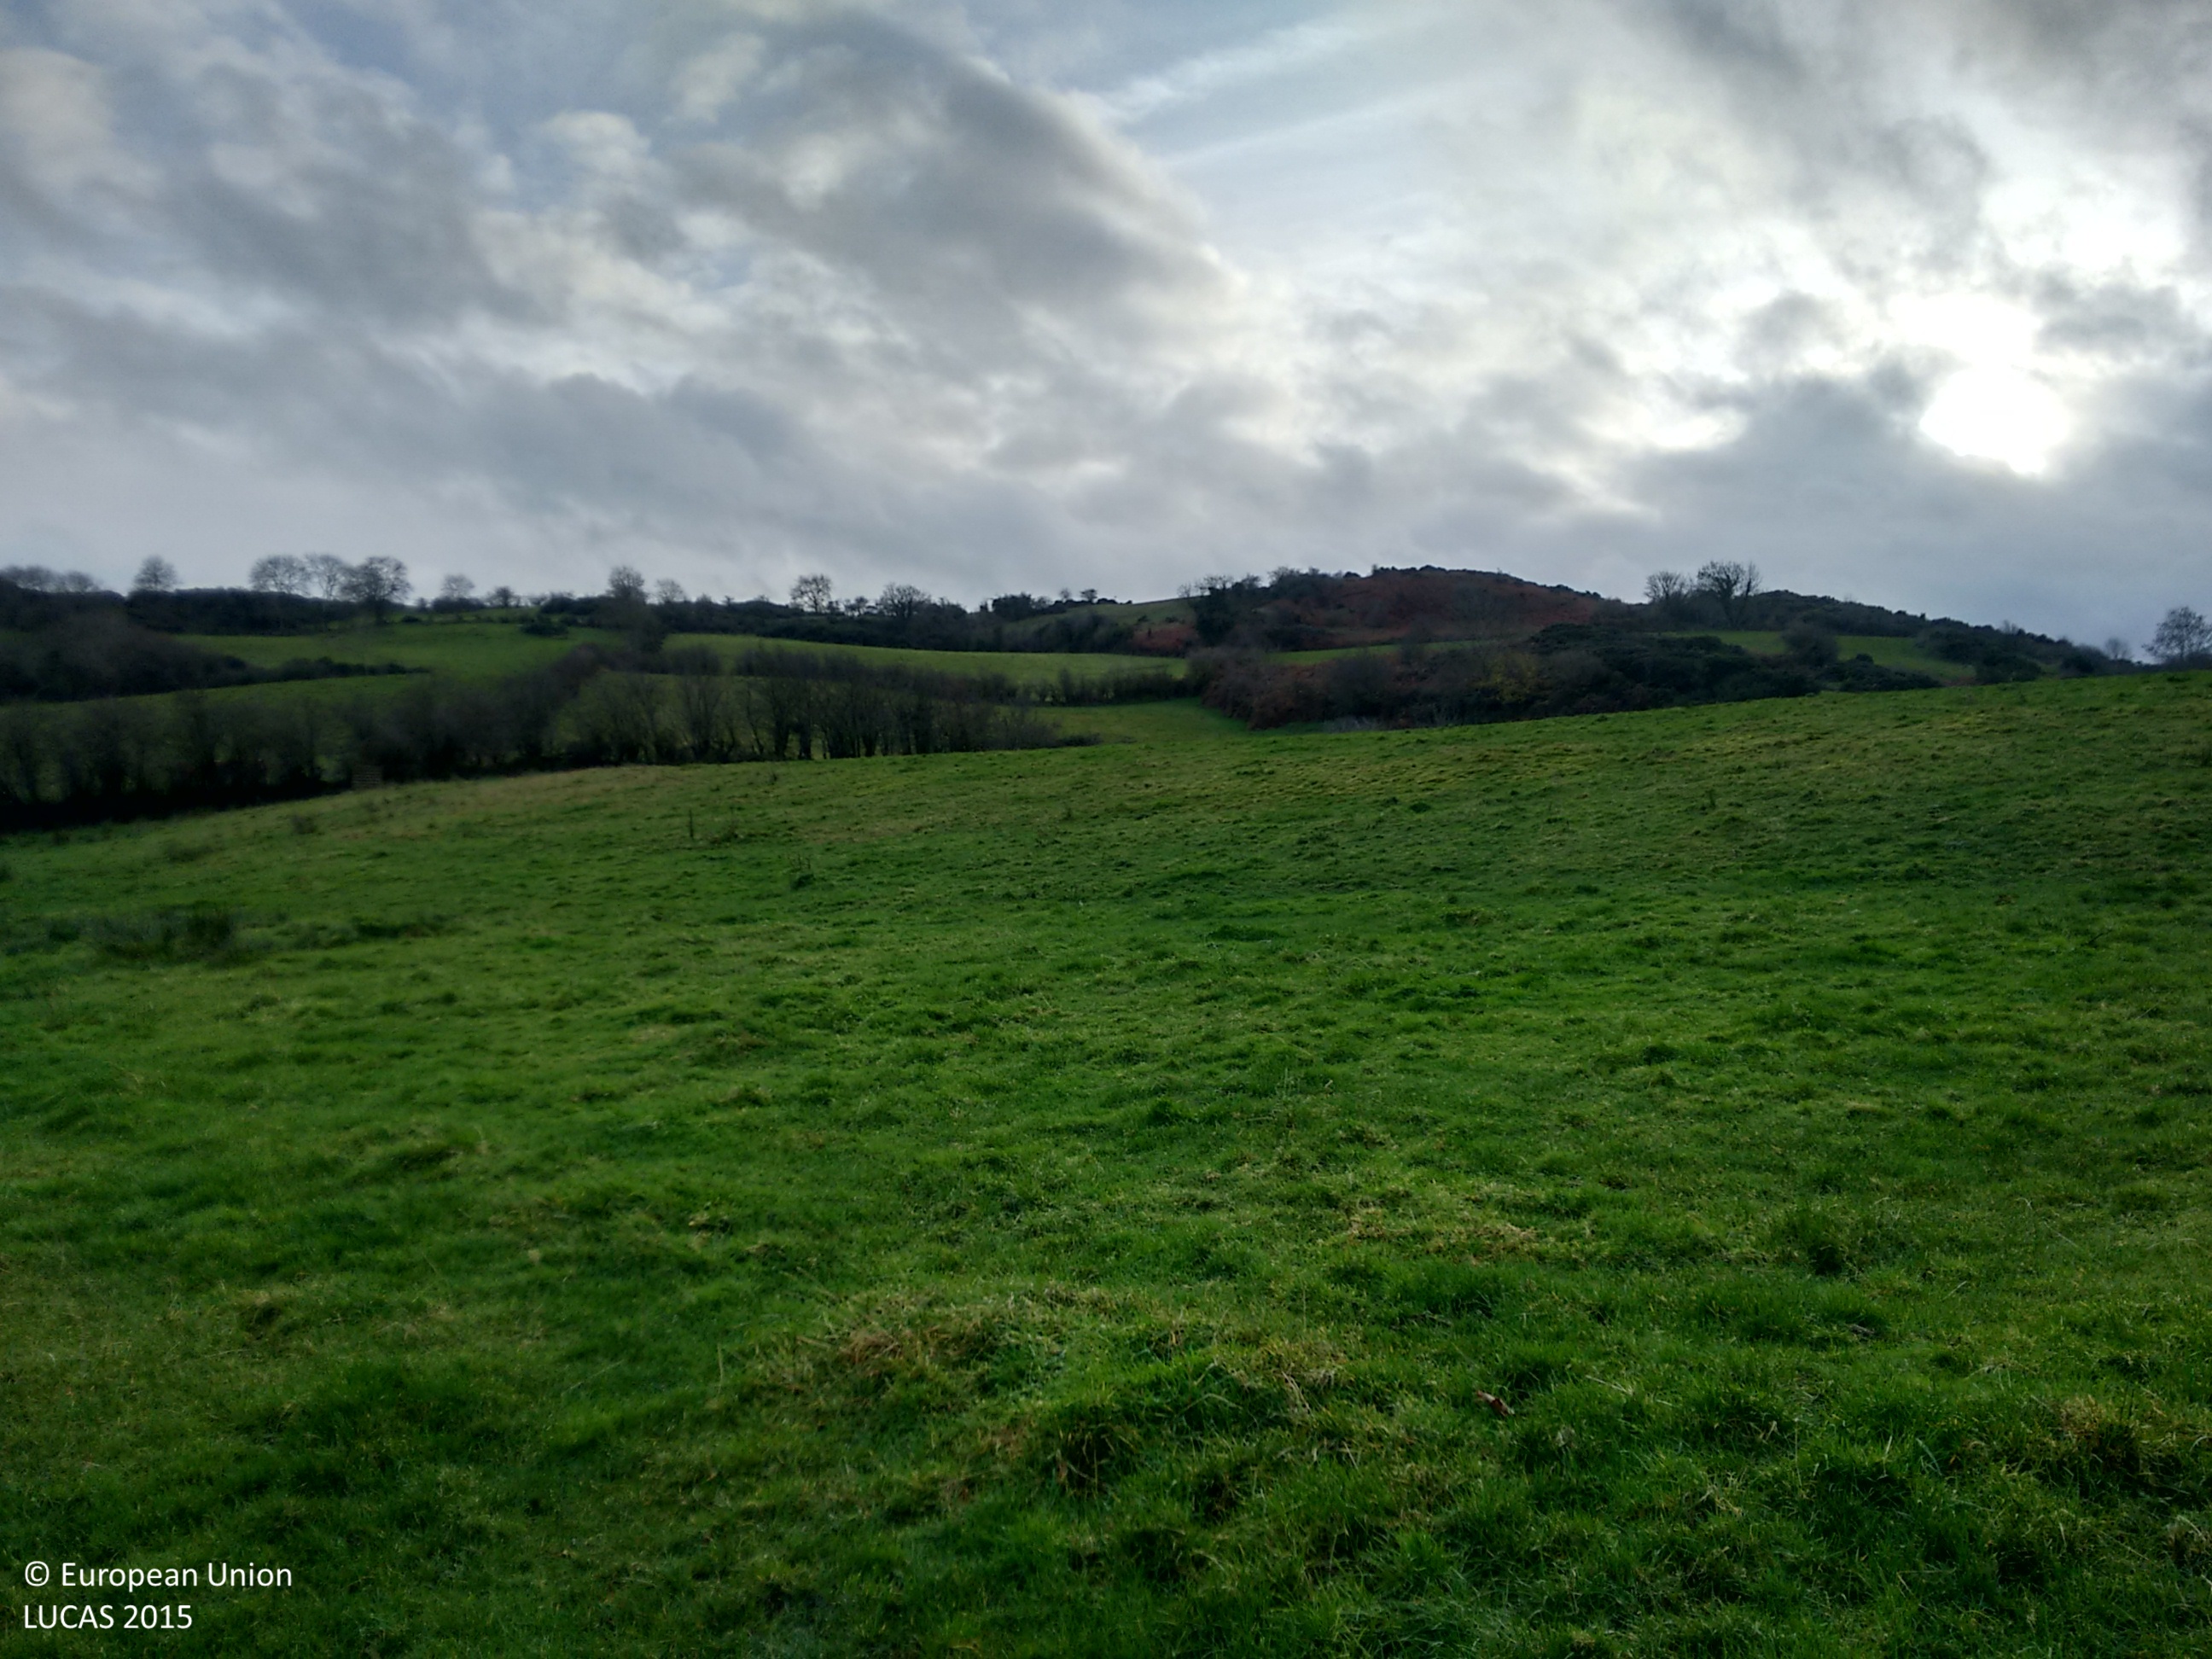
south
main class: Grassland
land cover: Grassland without tree/shrub cover
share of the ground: > 75 %
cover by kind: herbaceous plants 100 %
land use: Agriculture (excluding fallow land and kitchen gardens)
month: December
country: IE
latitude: 53.9690
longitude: -6.8910
